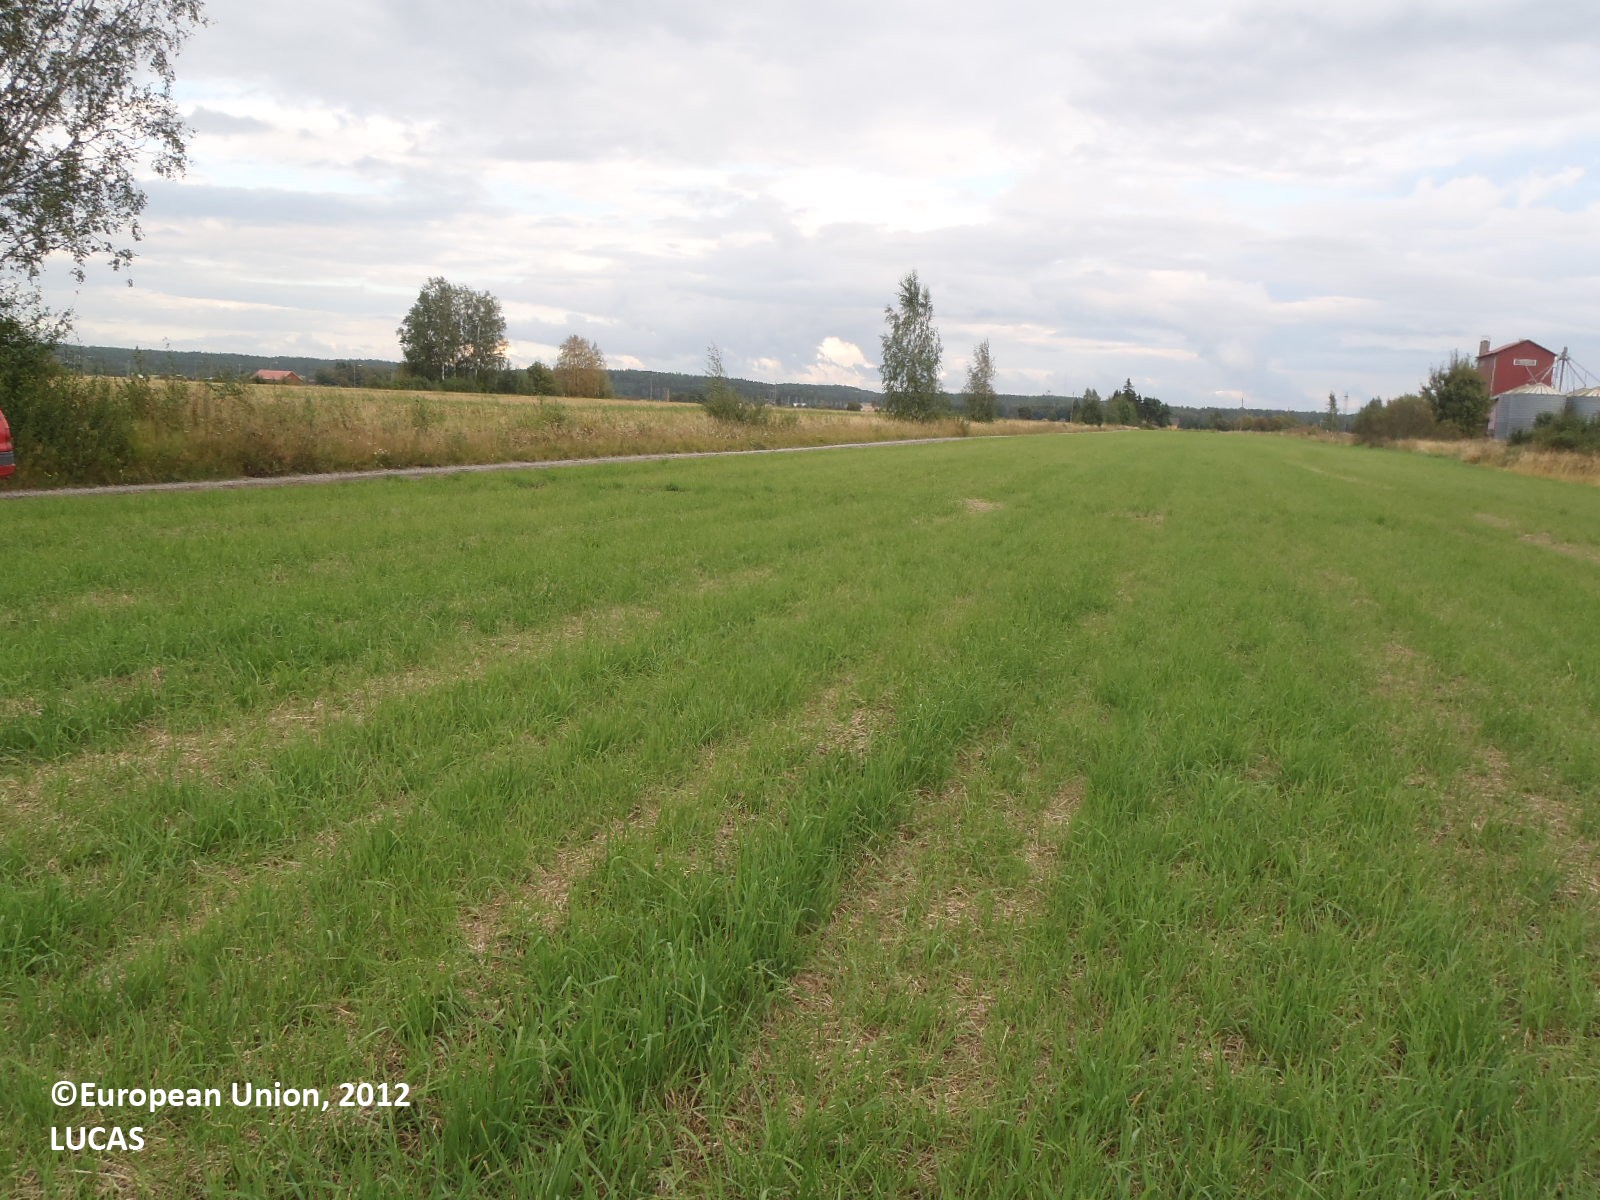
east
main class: Cropland
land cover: Temporary grasslands
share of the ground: > 75 %
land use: Agriculture (excluding fallow land and kitchen gardens)
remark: Harvested field
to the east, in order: Temporary grasslands; Paved roads, cycling and walking lanes; Grass margins; Ditches and canals; Grass margins; Temporary grasslands; Grass margins; Ditches and canals; Grass margins; Common wheat; Ditches and canals; Single bushes/trees; Grass margins; Temporary grasslands; Ditches and canals; Grass margins; Paved roads, cycling and walking lanes; Grass margins; Ditches and canals; Grass margins; Common wheat
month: August
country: FI
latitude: 60.5917
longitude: 22.0582
